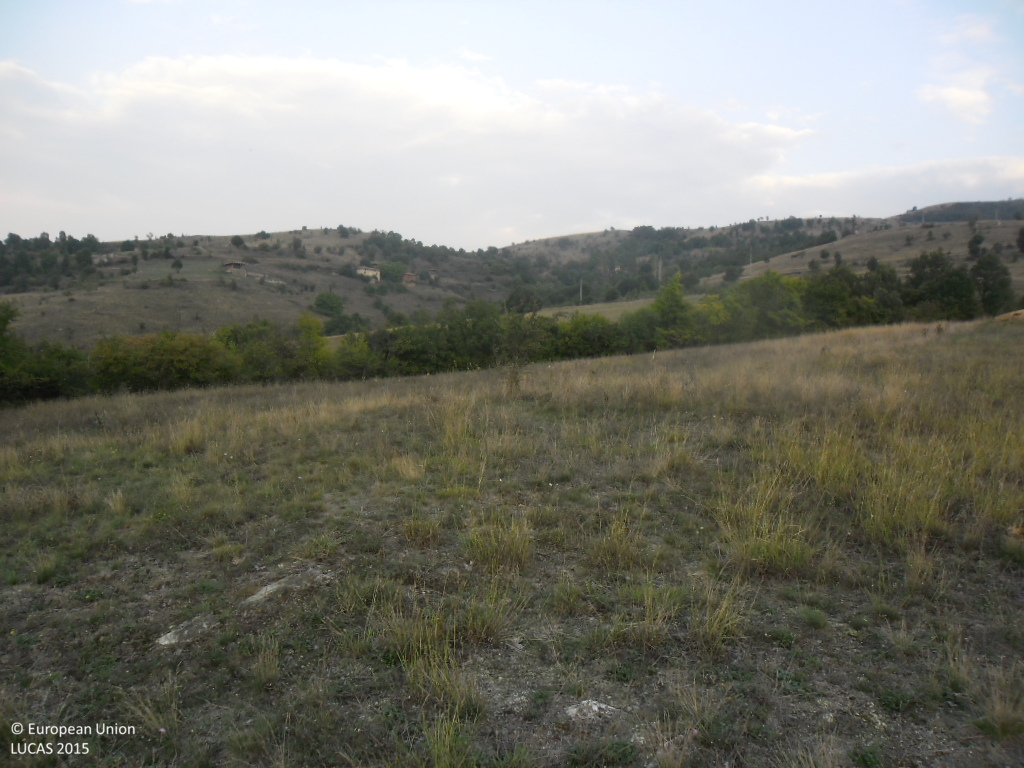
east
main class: Grassland
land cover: Grassland without tree/shrub cover
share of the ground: > 75 %
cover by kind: herbaceous plants 100 %
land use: Semi-natural and natural areas not in use
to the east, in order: Grassland without tree/shrub cover; Rye; Broadleaved woodland; Spontaneously vegetated surfaces; Tracks; Grassland with sparse tree/shrub cover; Broadleaved woodland
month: September
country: BG
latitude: 41.9386
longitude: 23.0123
